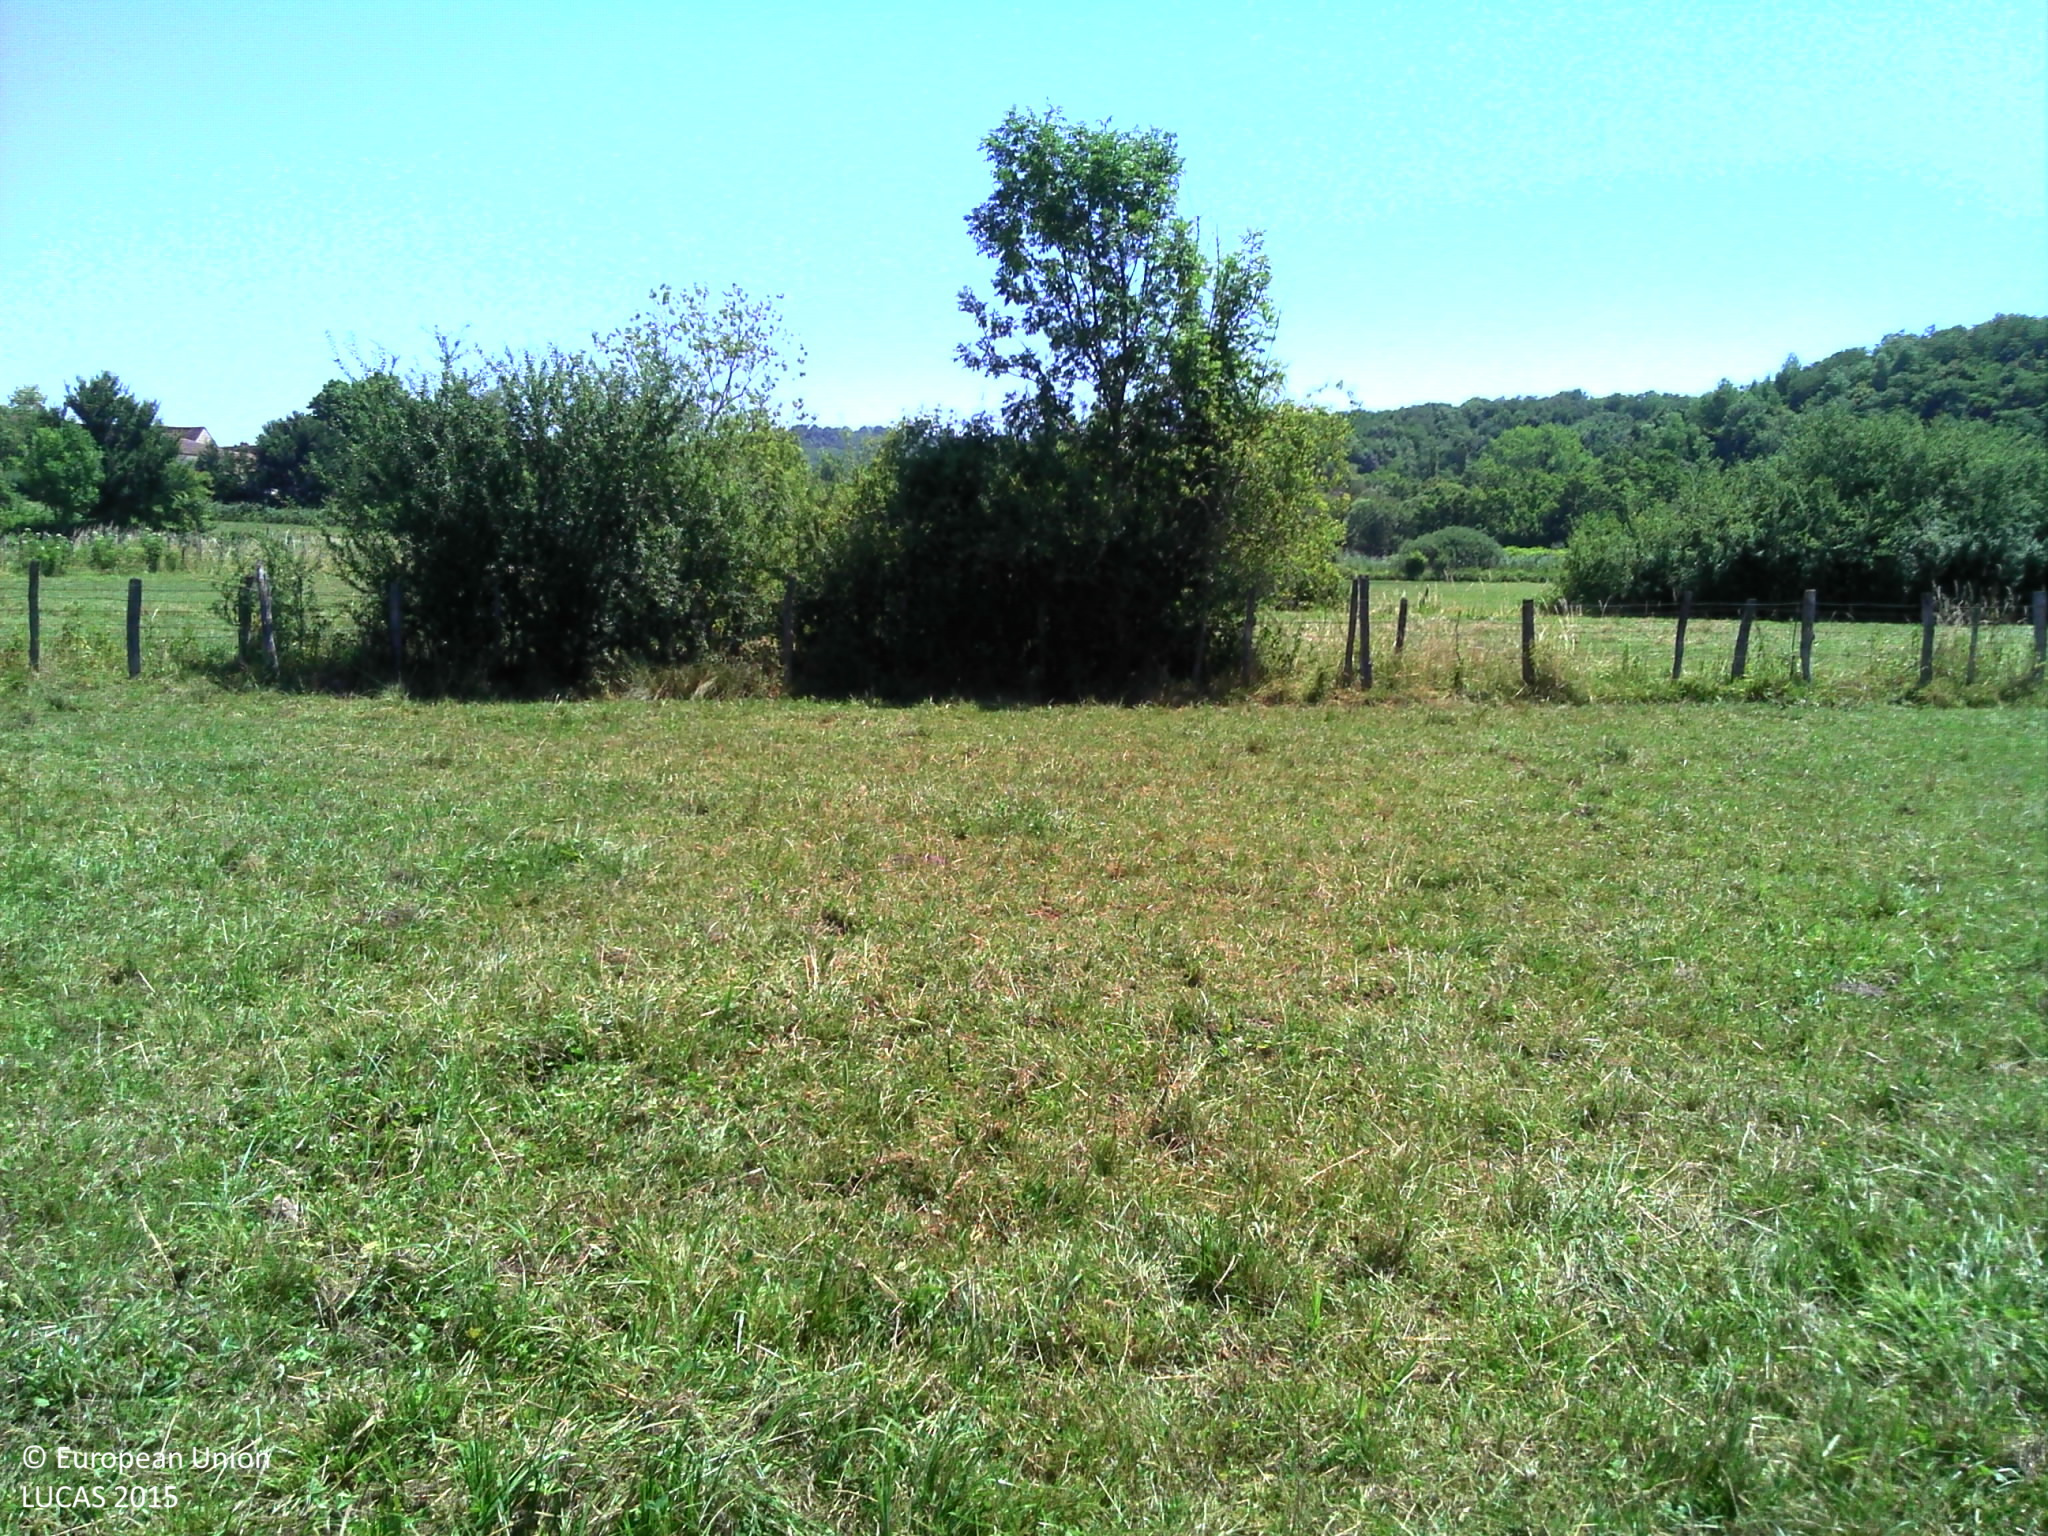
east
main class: Grassland
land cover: Grassland without tree/shrub cover
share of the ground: > 75 %
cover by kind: herbaceous plants 100 %
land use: Agriculture (excluding fallow land and kitchen gardens)
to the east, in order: Grassland without tree/shrub cover; Fences; Abandoned hedges; Fences; Grassland without tree/shrub cover; Lines of trees; Fences; Grassland without tree/shrub cover; Fences; Managed hedges; Grass margins; Paved roads, cycling and walking lanes; Grass margins; Ditches and canals; Fences; Managed hedges; Grassland without tree/shrub cover; Spontaneously vegetated surfaces; Fences; Apple fruit
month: June
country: FR
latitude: 46.6711
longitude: 5.4927
